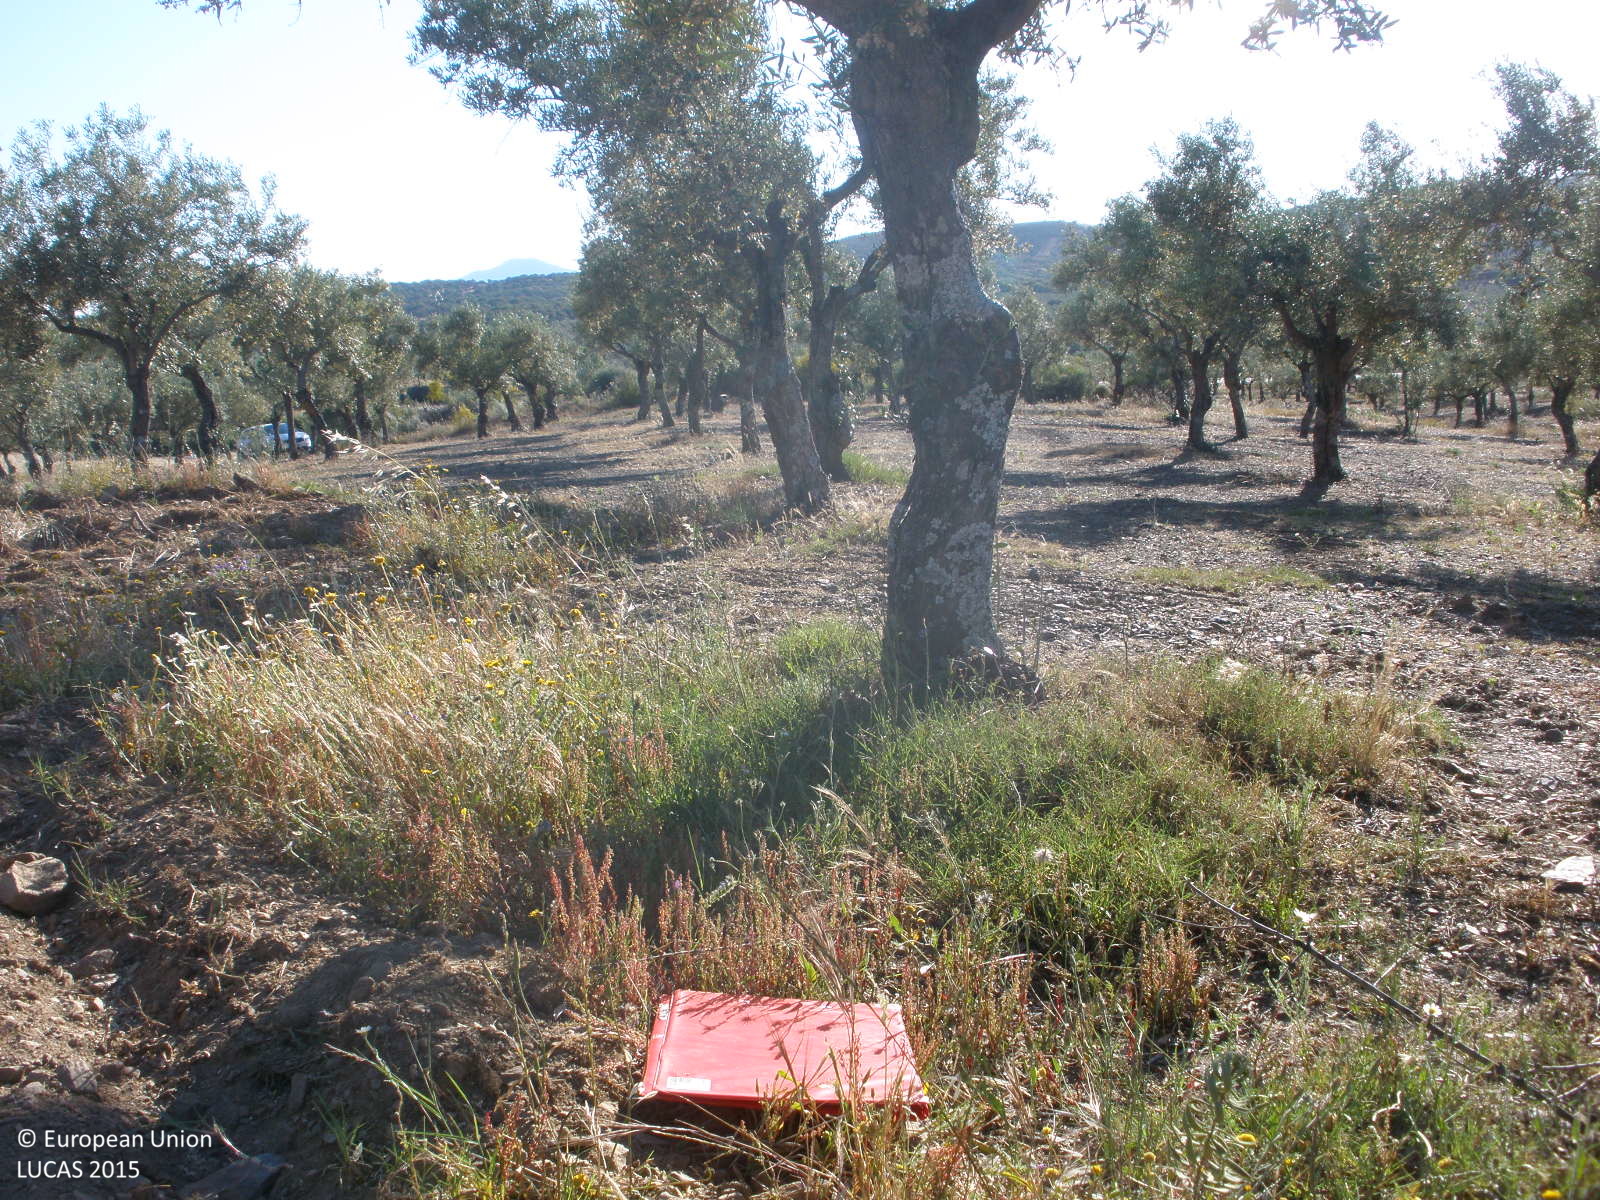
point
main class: Cropland
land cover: Olive groves
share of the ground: 50 - 75 %
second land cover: Spontaneously vegetated surfaces
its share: > 75 %
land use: Agriculture (excluding fallow land and kitchen gardens)
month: May
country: ES
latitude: 40.2552
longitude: -6.1963
